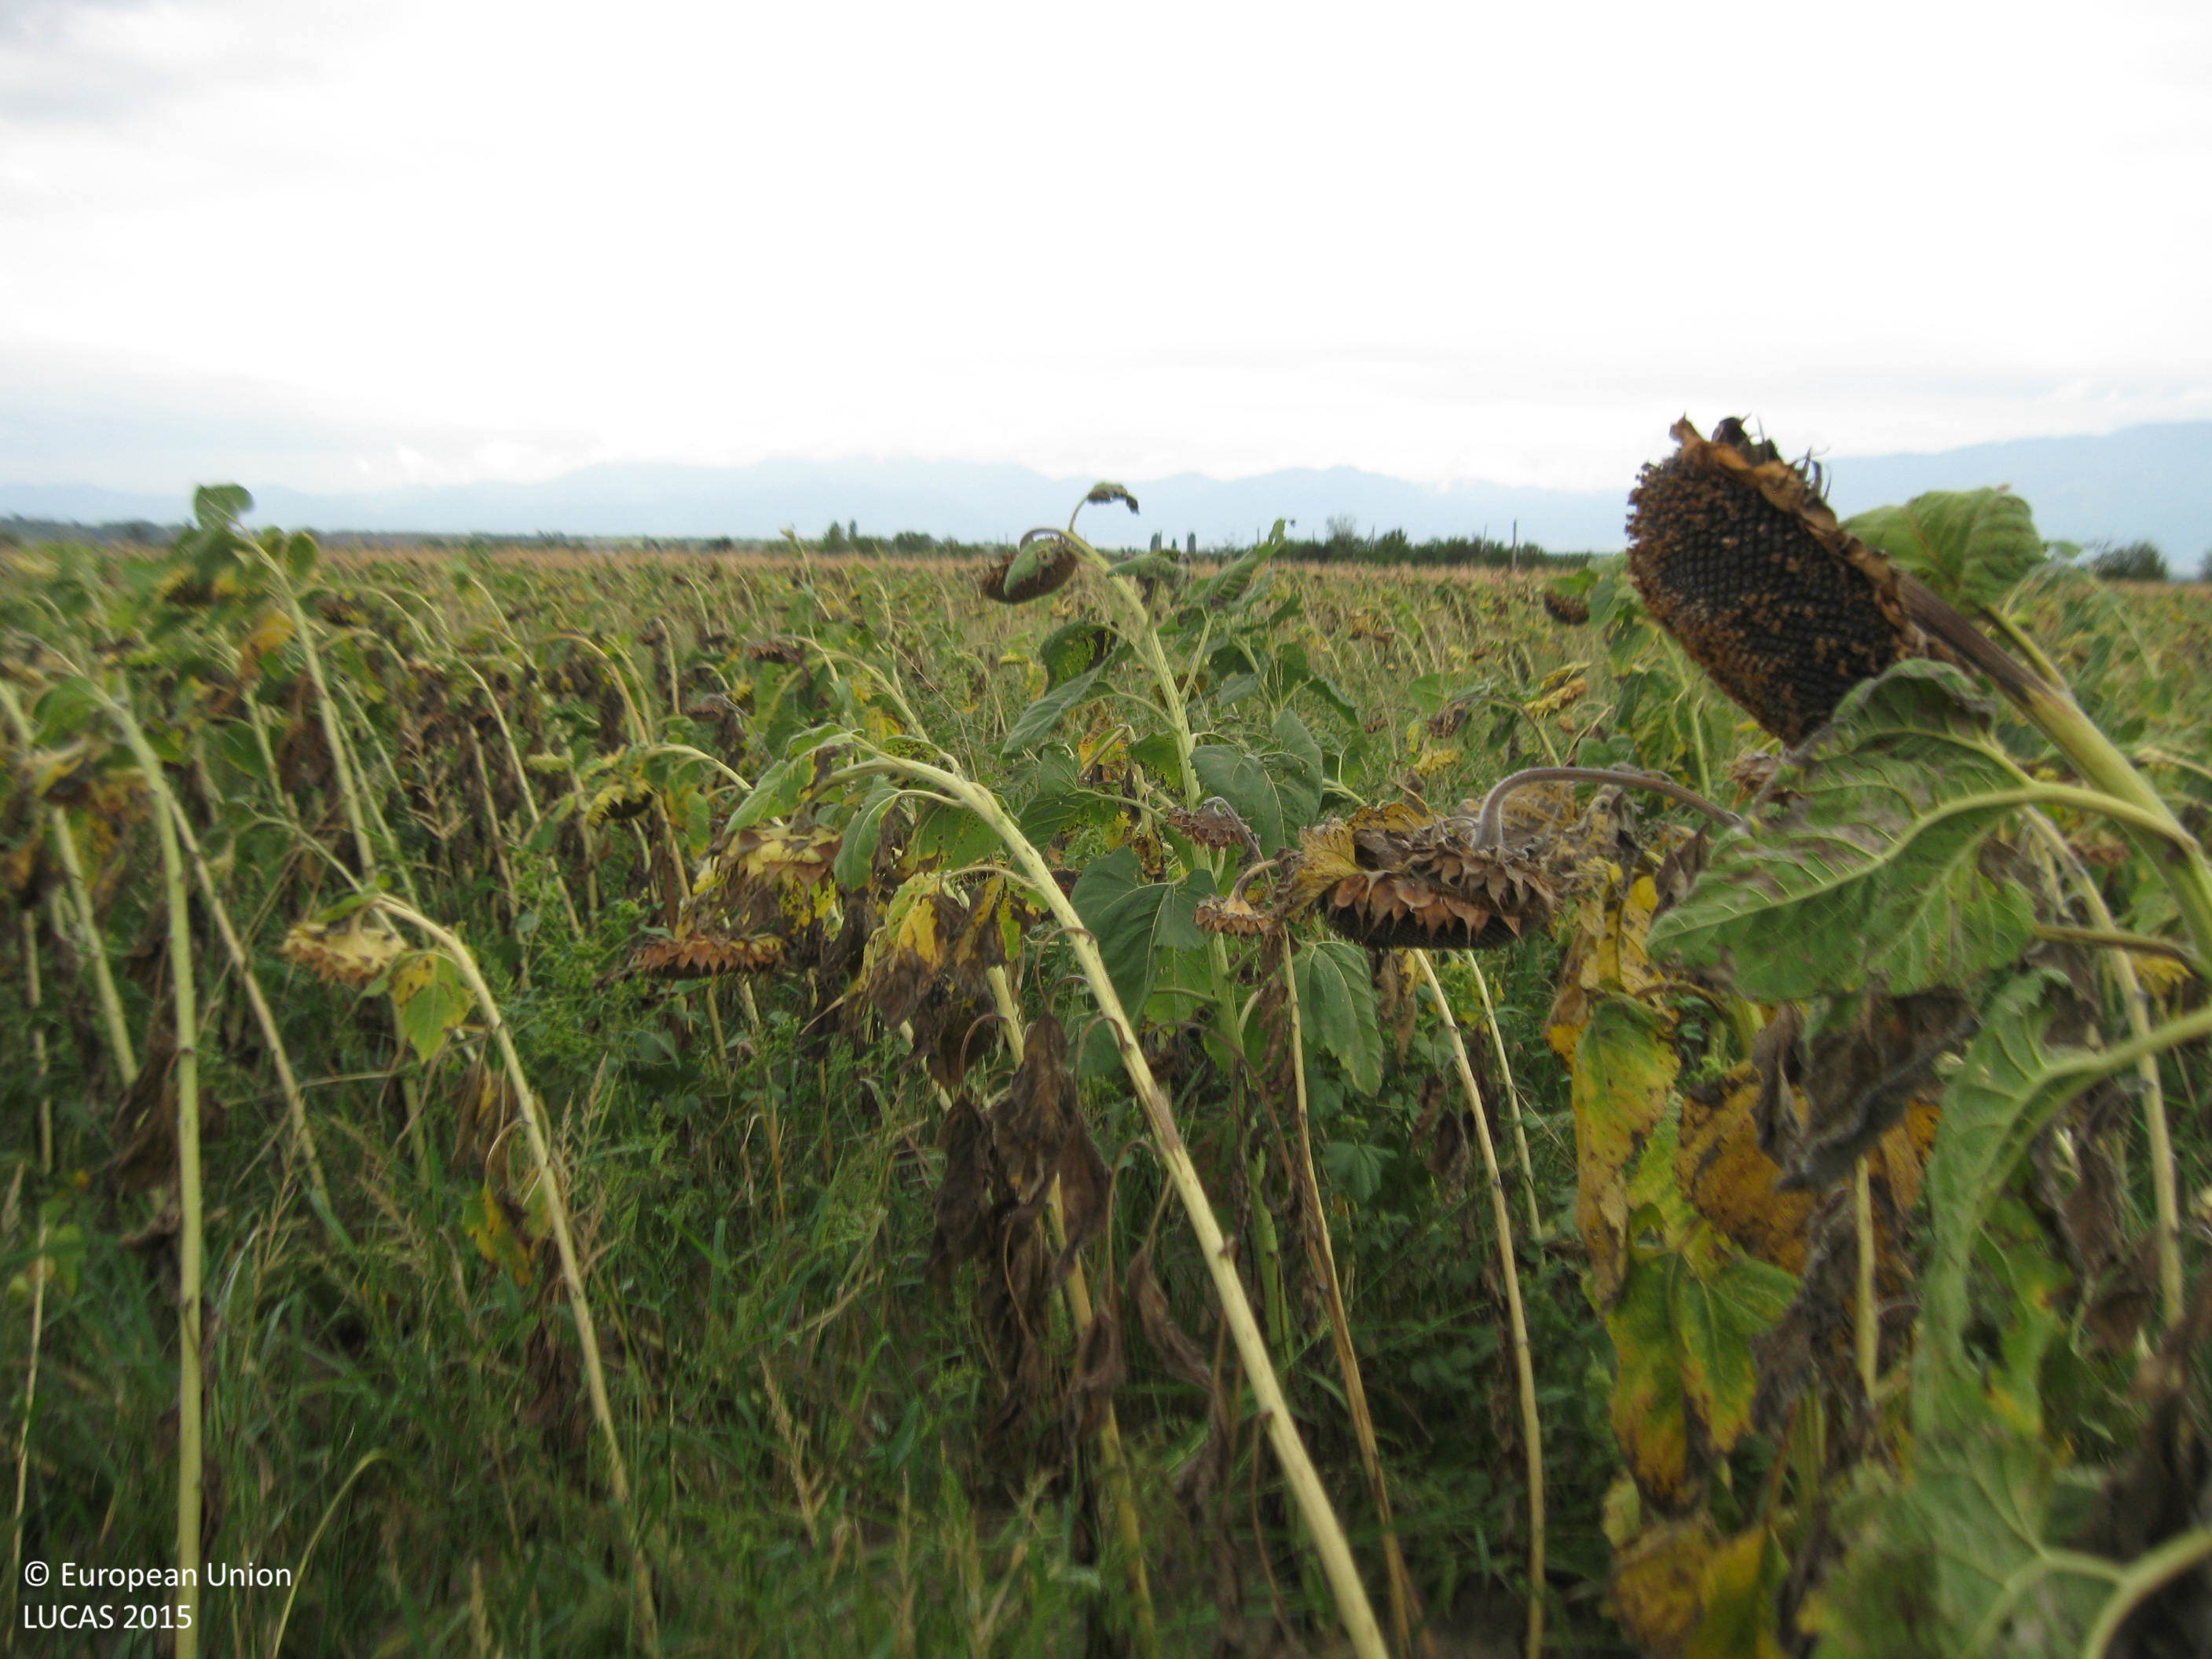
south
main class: Cropland
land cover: Sunflower
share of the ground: 50 - 75 %
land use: Agriculture (excluding fallow land and kitchen gardens)
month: September
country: BG
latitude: 42.0610
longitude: 25.0034
